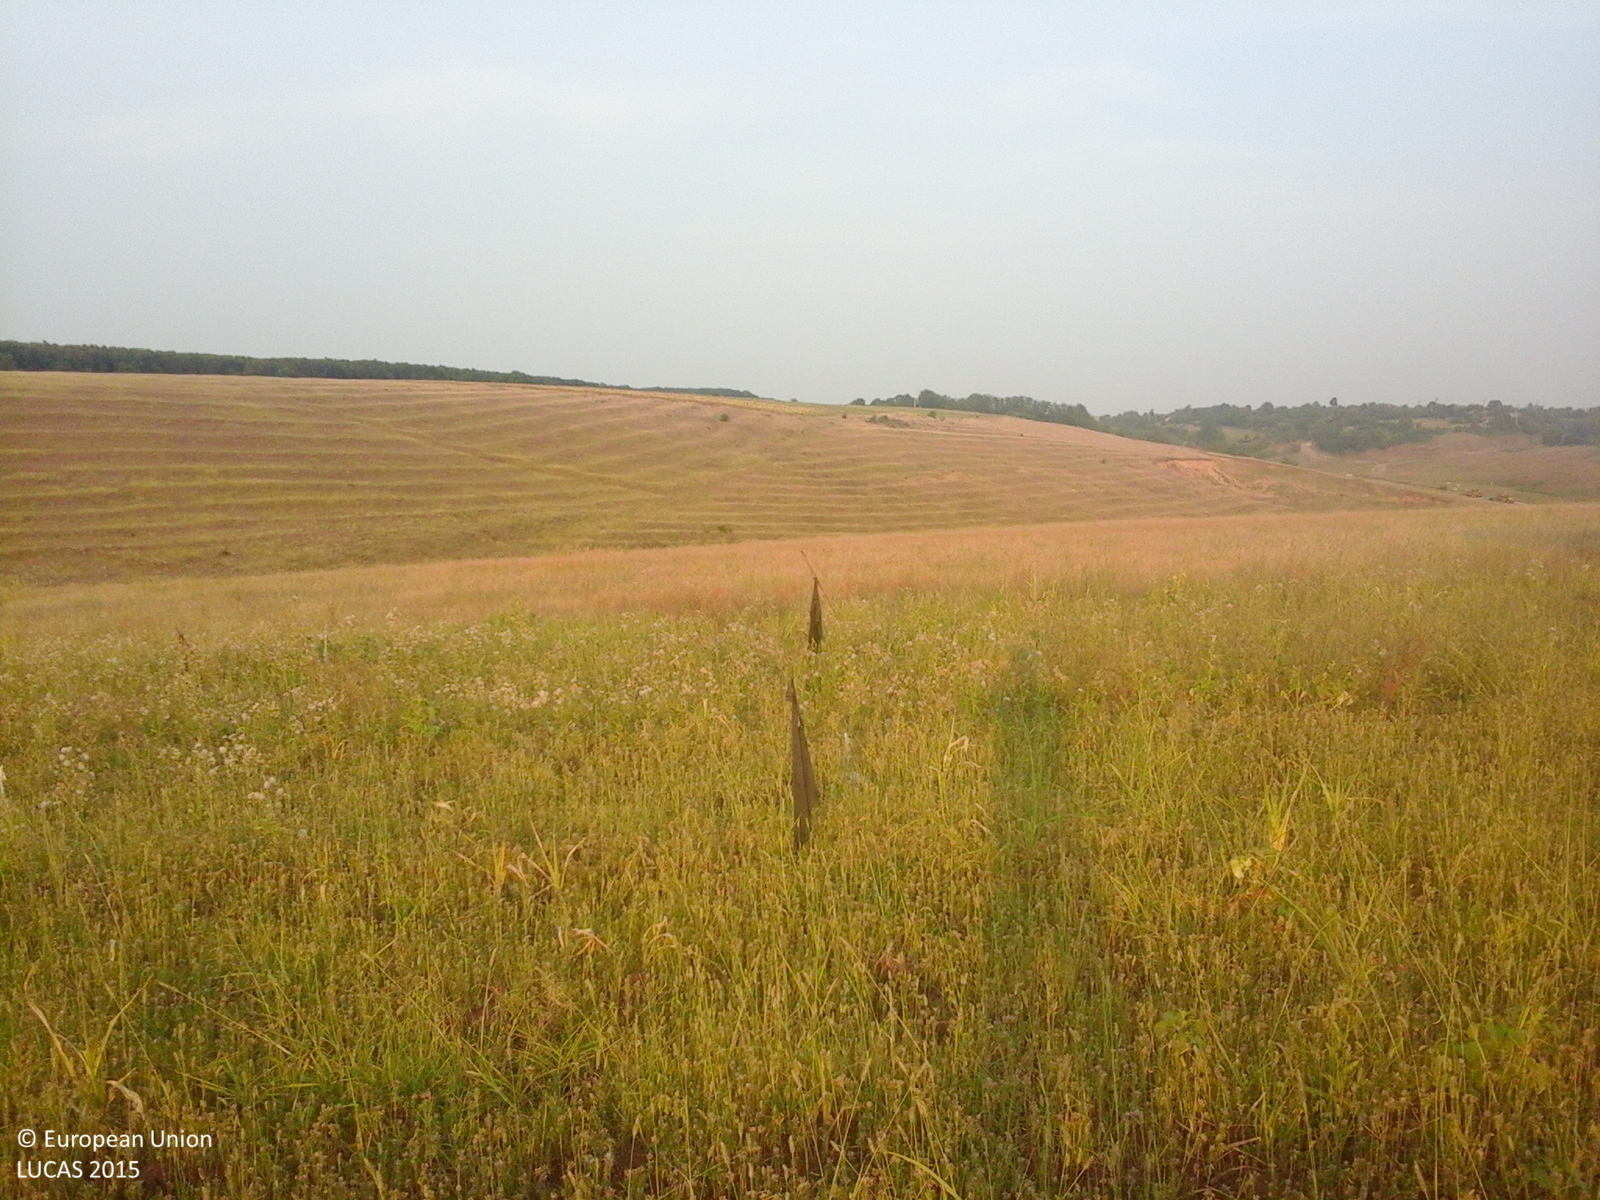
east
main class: Grassland
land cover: Spontaneously vegetated surfaces
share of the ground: > 75 %
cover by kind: herbaceous plants 100 %
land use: Fallow land
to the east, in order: Spontaneously vegetated surfaces; Grassland without tree/shrub cover; Common wheat; Grassland without tree/shrub cover; Tracks; Grass margins; Tracks; Grassland without tree/shrub cover
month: August
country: RO
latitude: 44.2311
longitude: 23.6370
